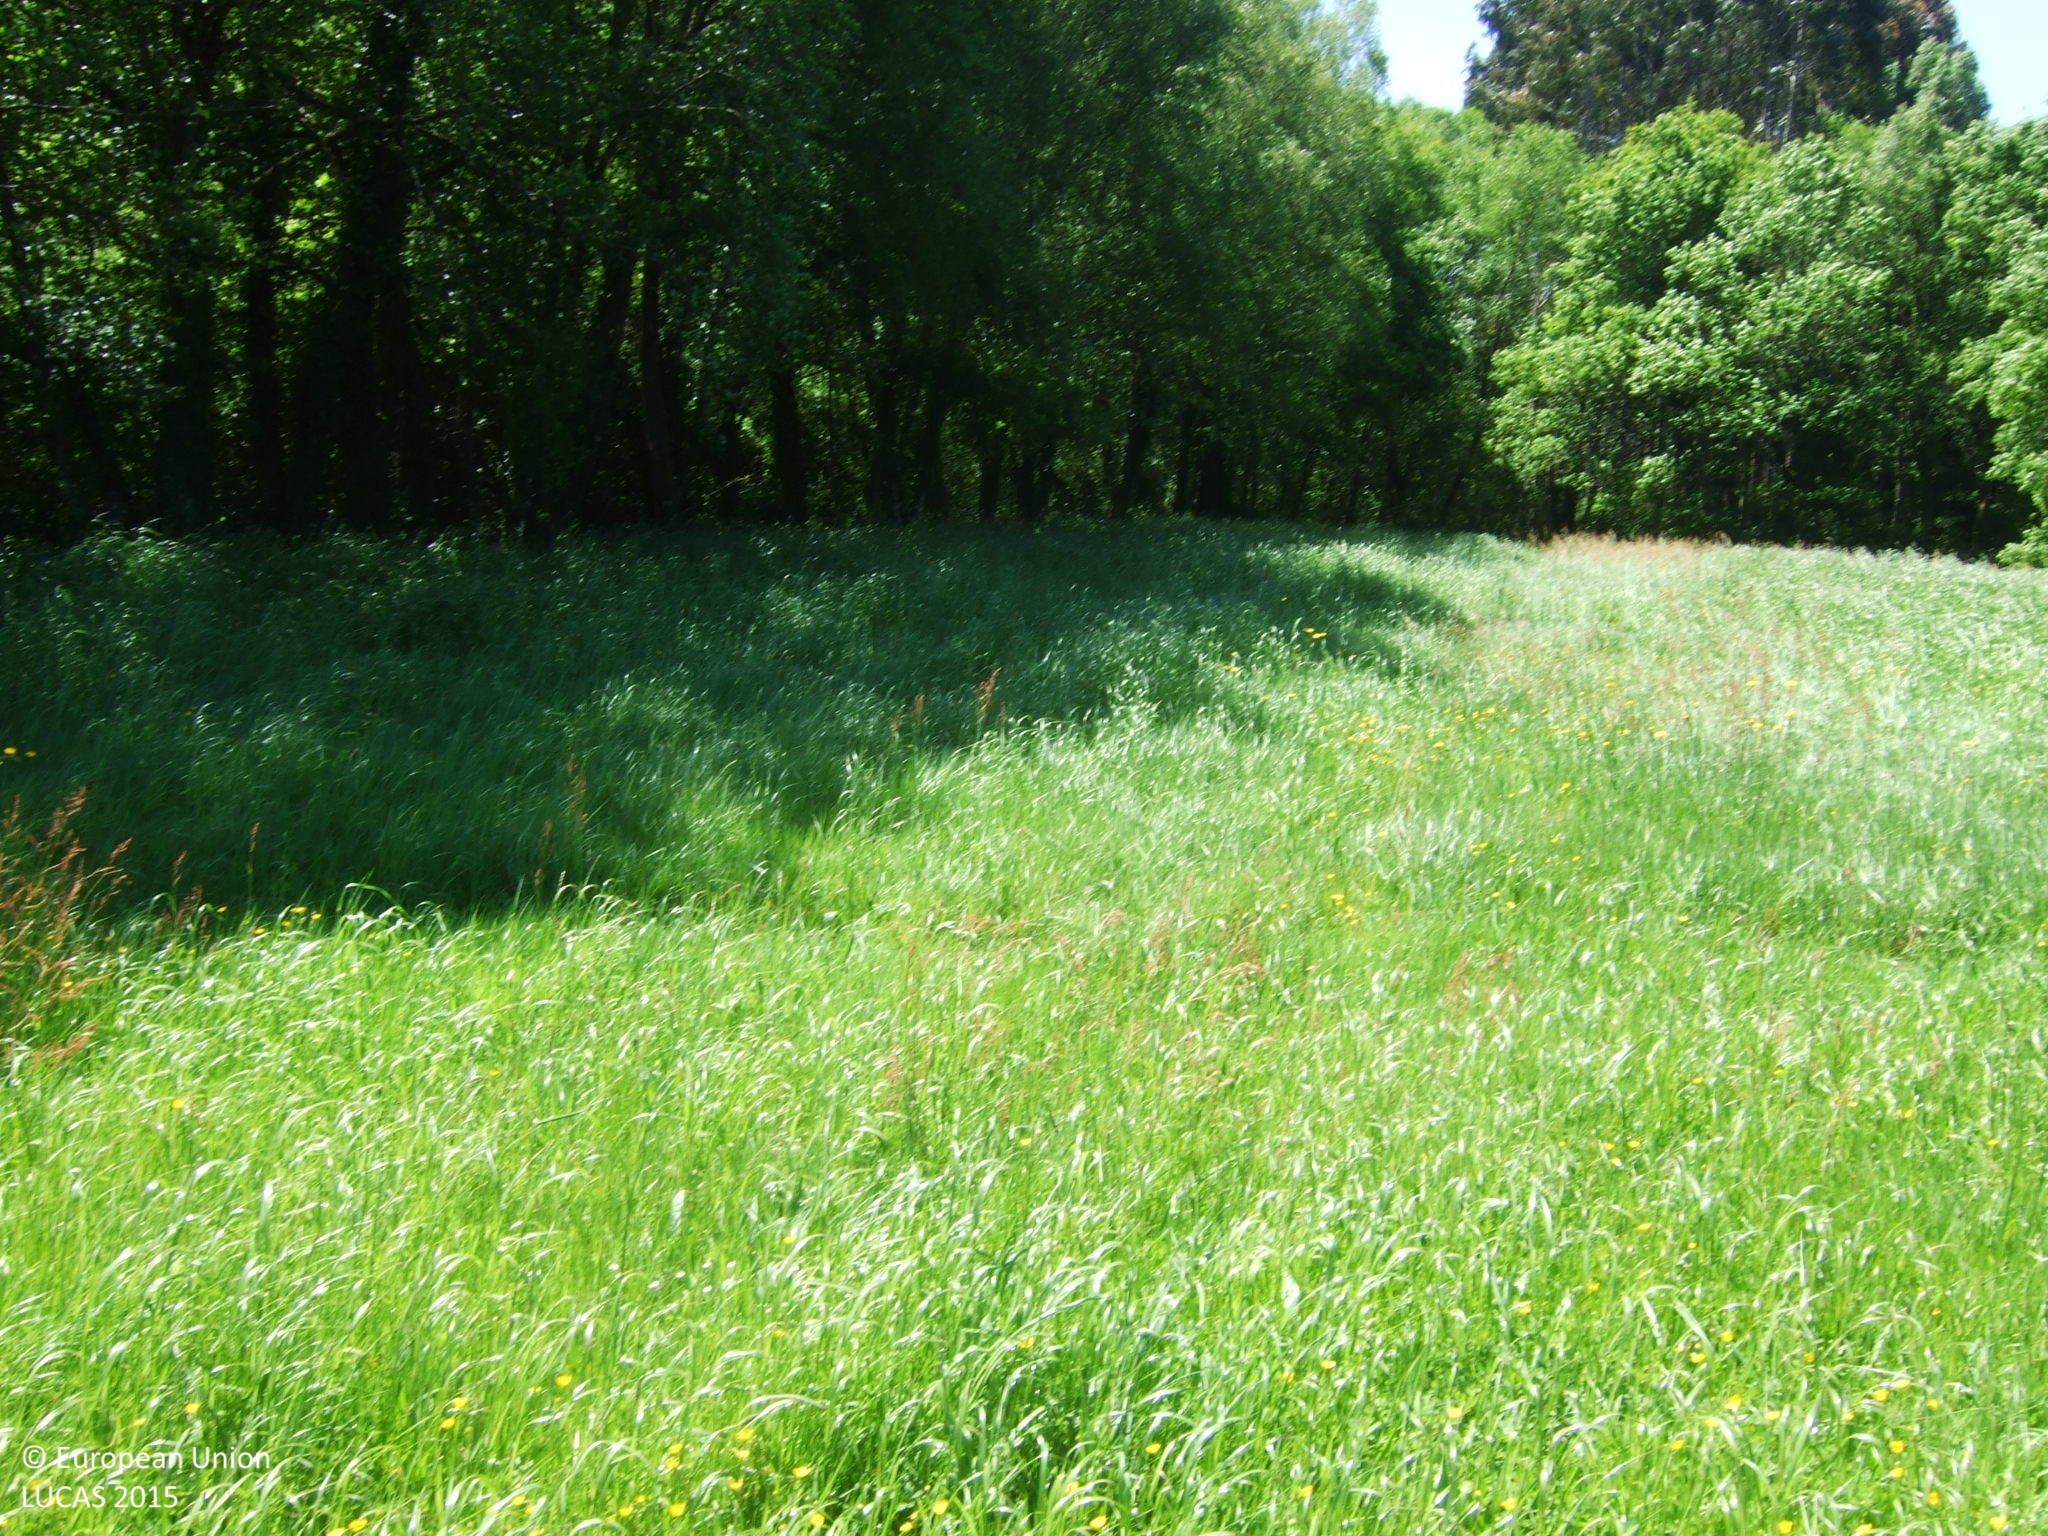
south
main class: Cropland
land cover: Temporary grasslands
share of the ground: > 75 %
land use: Agriculture (excluding fallow land and kitchen gardens)
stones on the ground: < 10 %
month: May
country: ES
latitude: 43.2153
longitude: -7.7244
